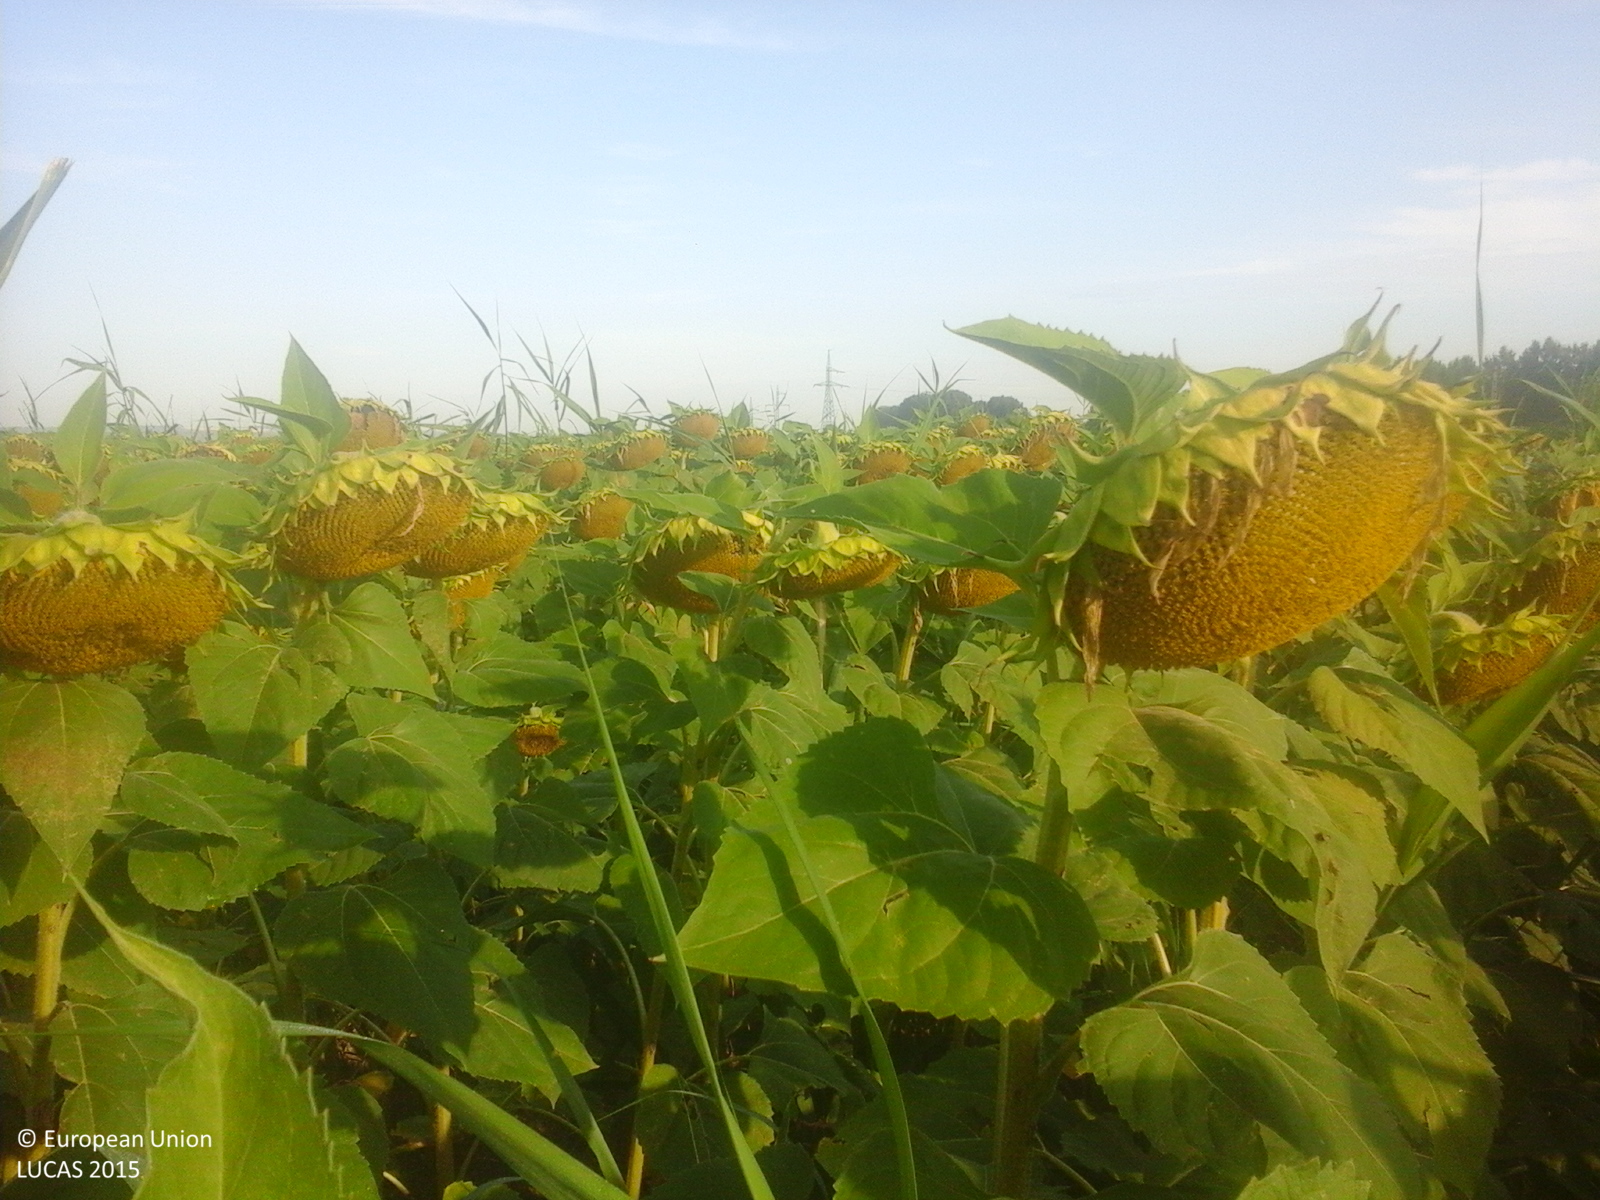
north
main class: Cropland
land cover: Sunflower
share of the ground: > 75 %
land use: Agriculture (excluding fallow land and kitchen gardens)
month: July
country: RO
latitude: 46.7096
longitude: 28.1989
